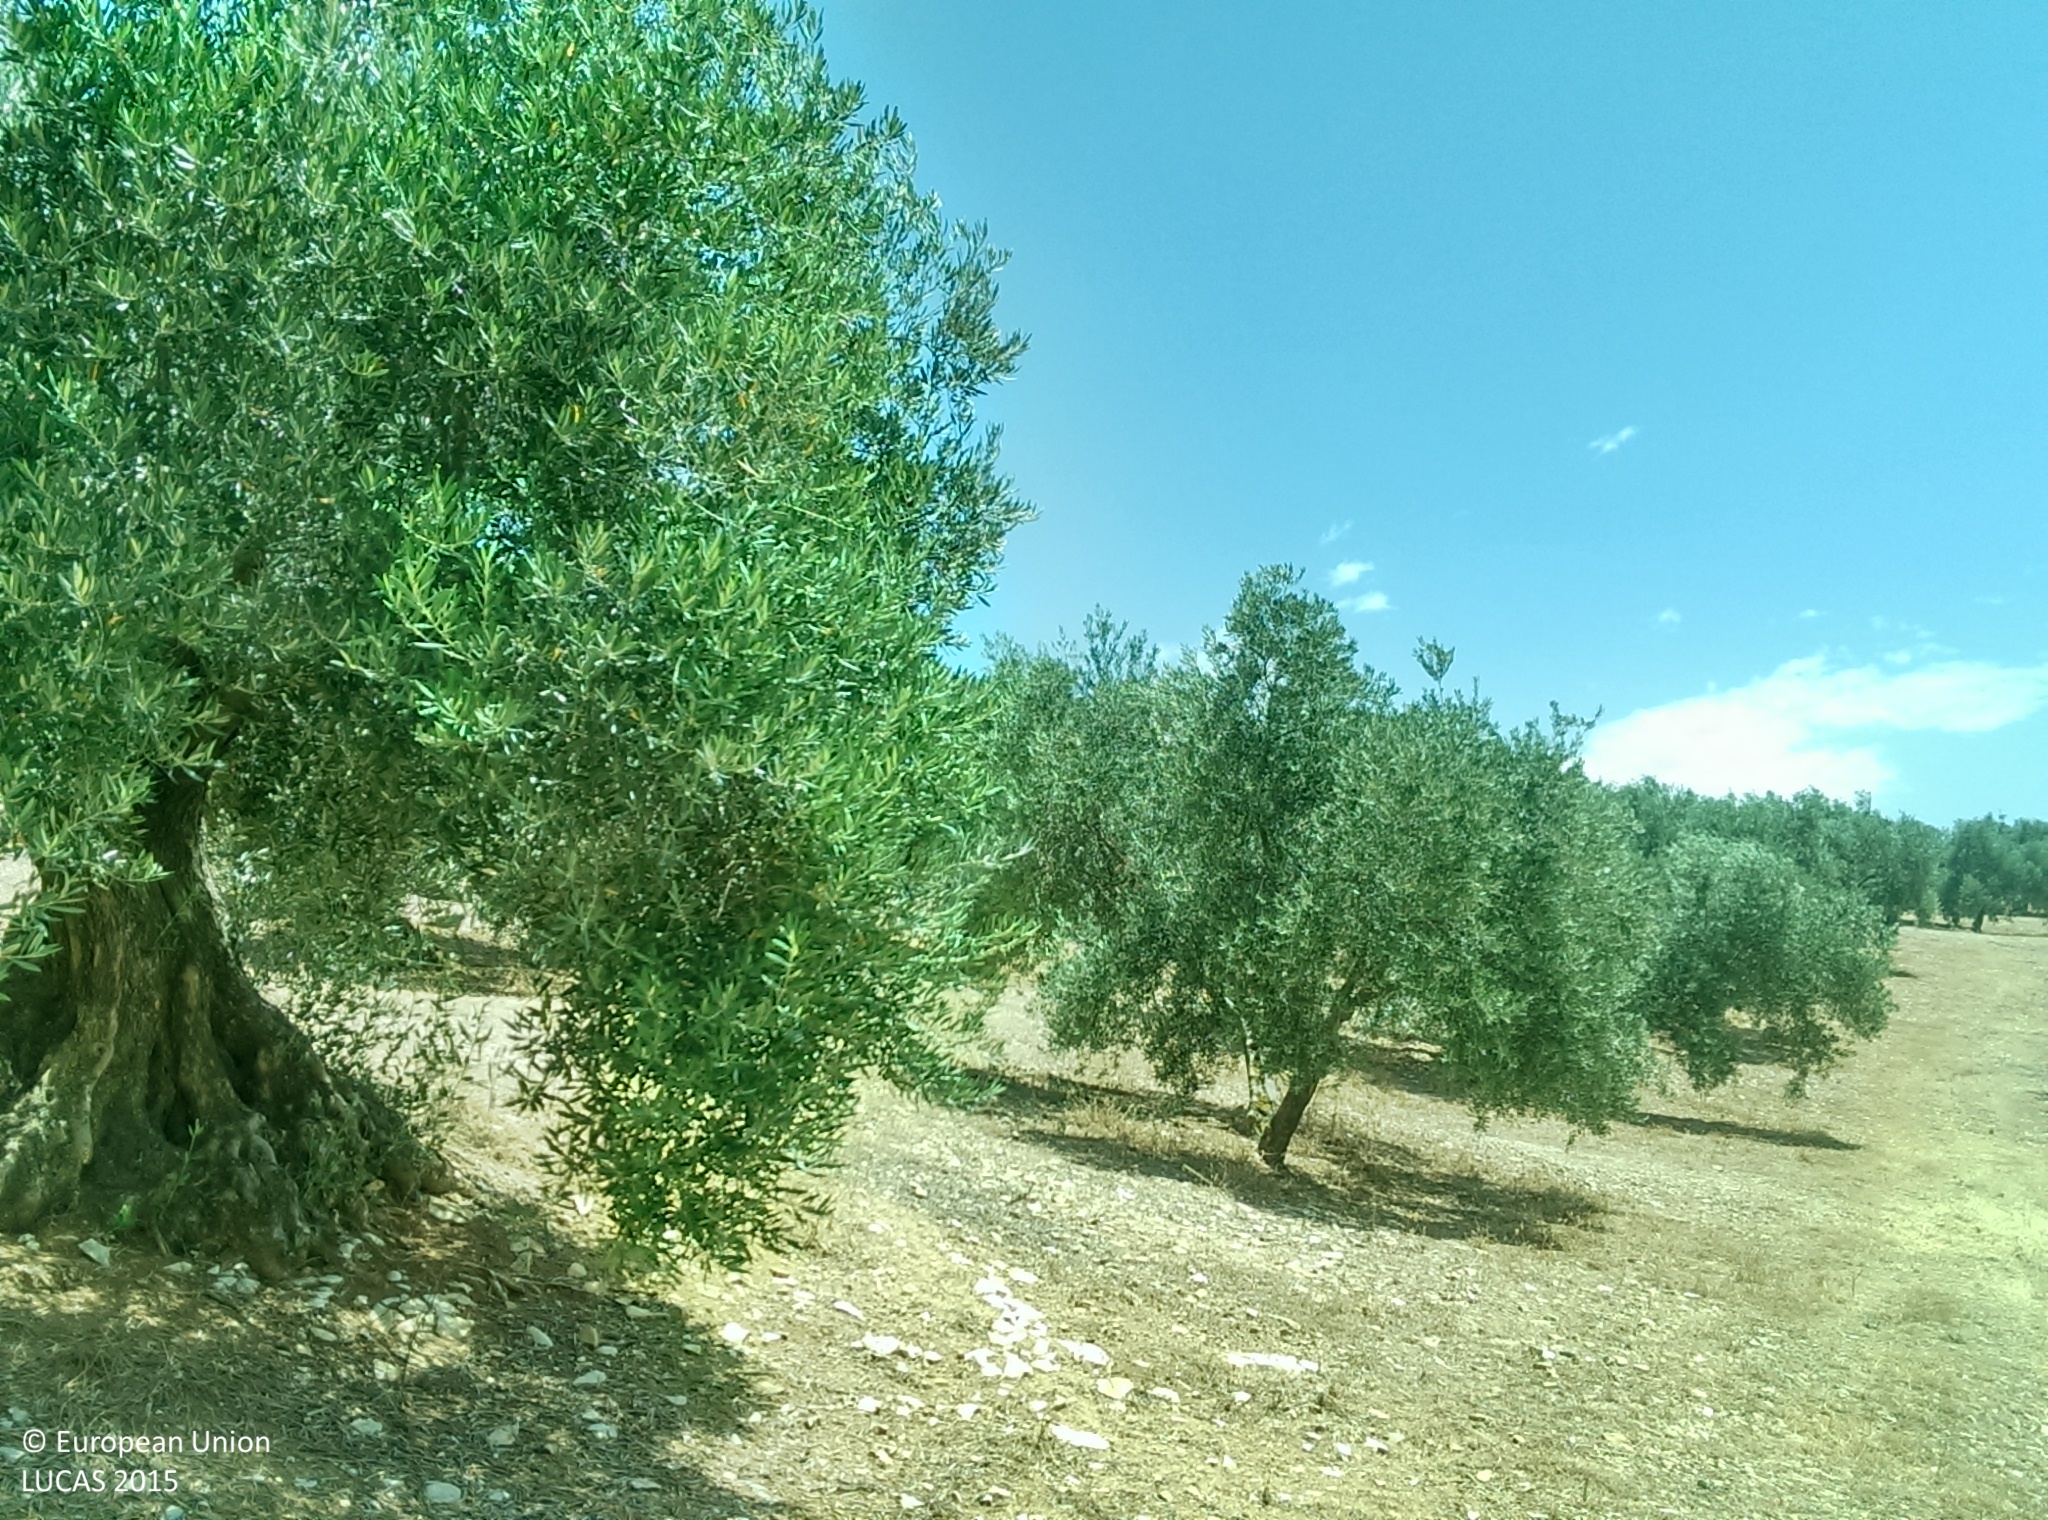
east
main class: Cropland
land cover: Olive groves
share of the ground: 50 - 75 %
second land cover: Spontaneously vegetated surfaces
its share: 10 - 25 %
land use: Agriculture (excluding fallow land and kitchen gardens)
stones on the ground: 10 - 25 %
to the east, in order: Olive groves; Spontaneously vegetated surfaces; Grass margins; Tracks; Shruby margins; Olive groves
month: July
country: ES
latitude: 37.4479
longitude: -3.7060
